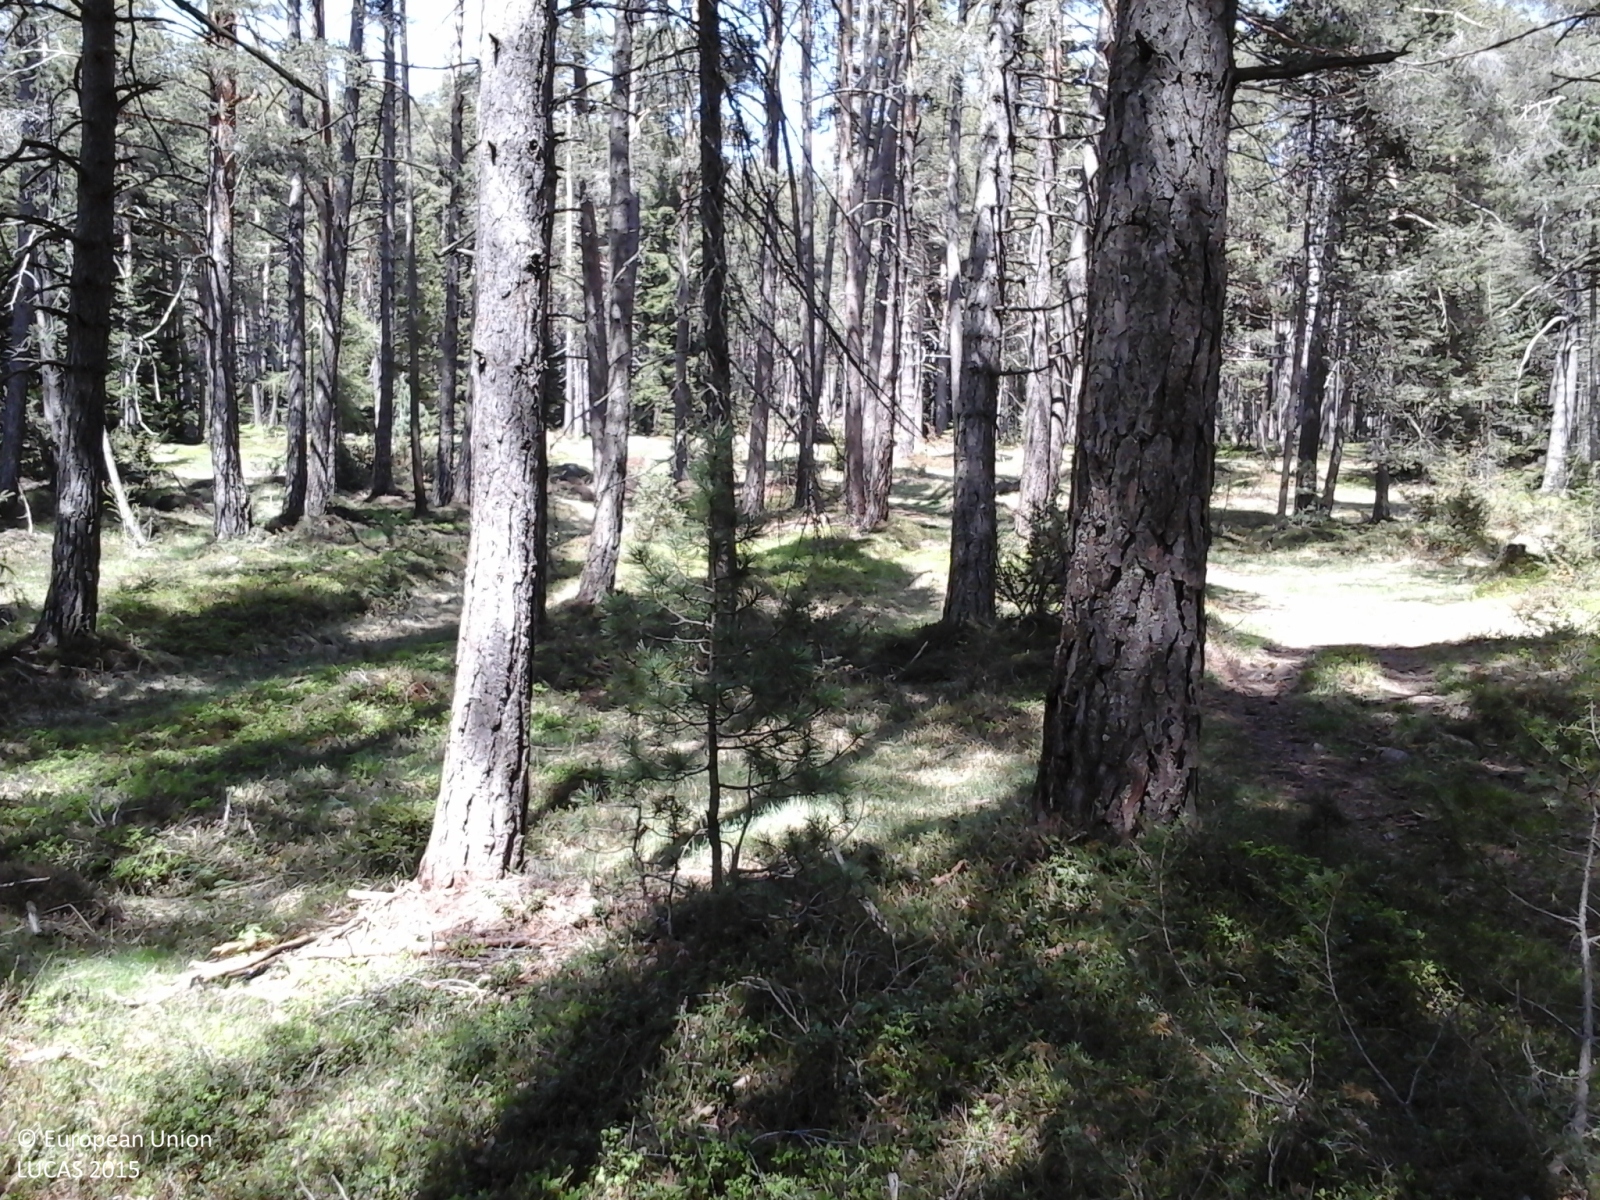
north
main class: Woodland
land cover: Spruce dominated coniferous woodland
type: alpine coniferous forest
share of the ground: > 75 %
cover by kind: coniferous forest trees 100 %
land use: Forestry
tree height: > 5 m
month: May
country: IT
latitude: 46.5576
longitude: 11.4462
